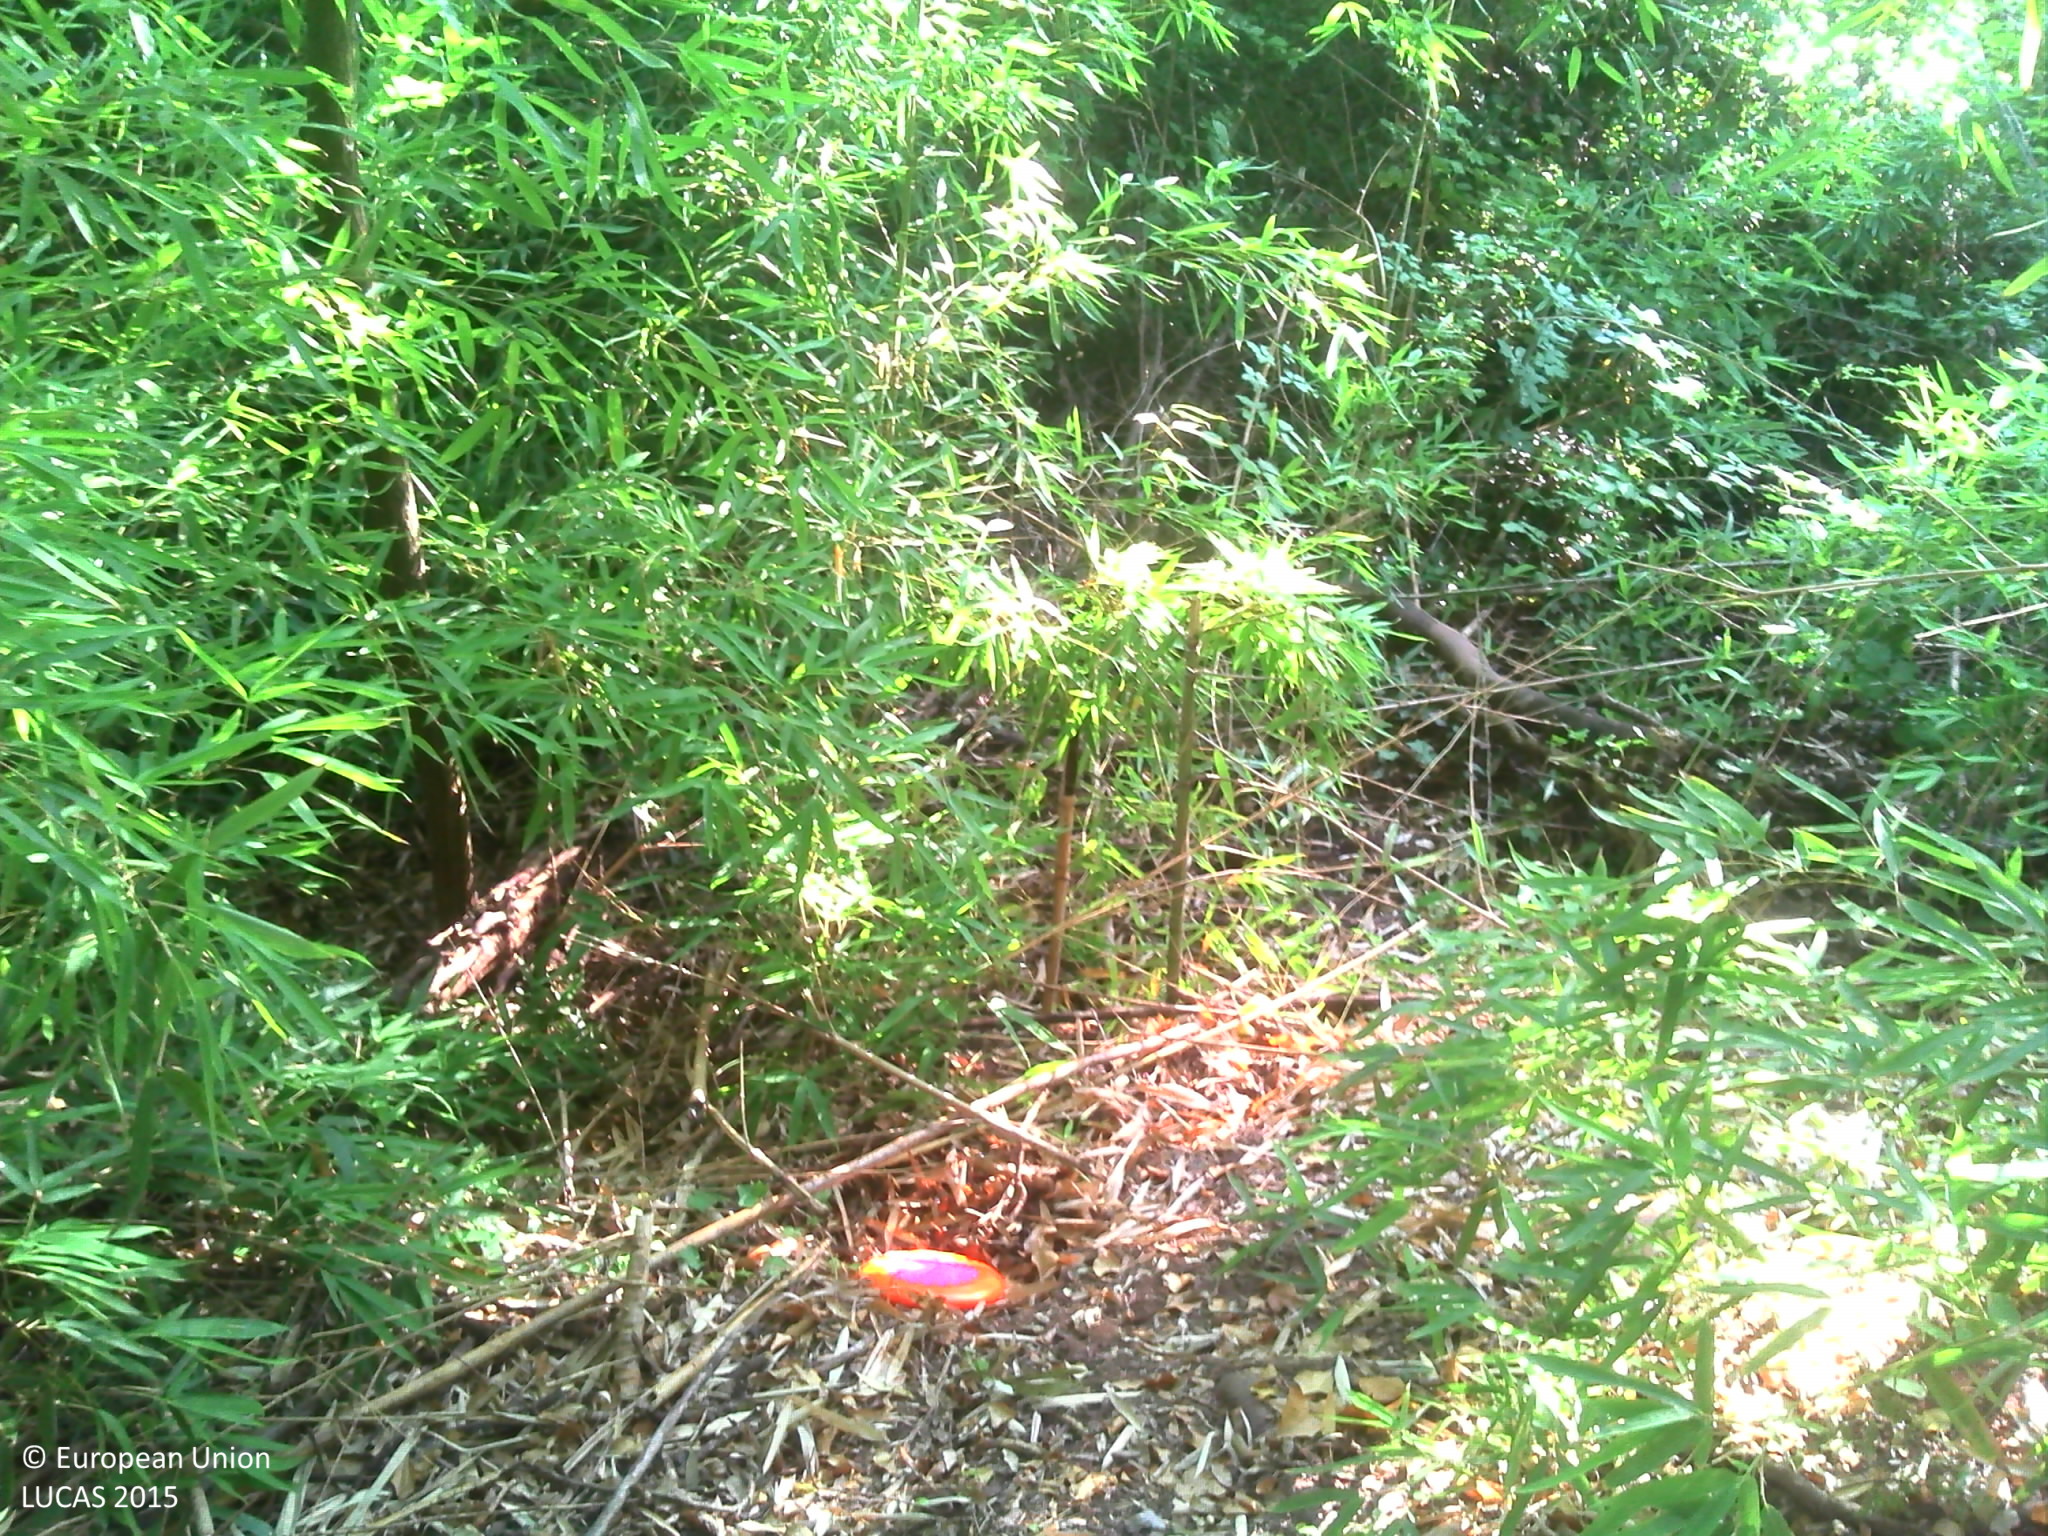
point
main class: Woodland
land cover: Broadleaved woodland
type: boreal forest
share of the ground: > 75 %
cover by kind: broadleaved forest trees 90 %, shrubs 10 %
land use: Semi-natural and natural areas not in use
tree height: > 5 m
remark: Temporary flooded
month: July
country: FR
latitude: 43.3840
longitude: 6.3675
